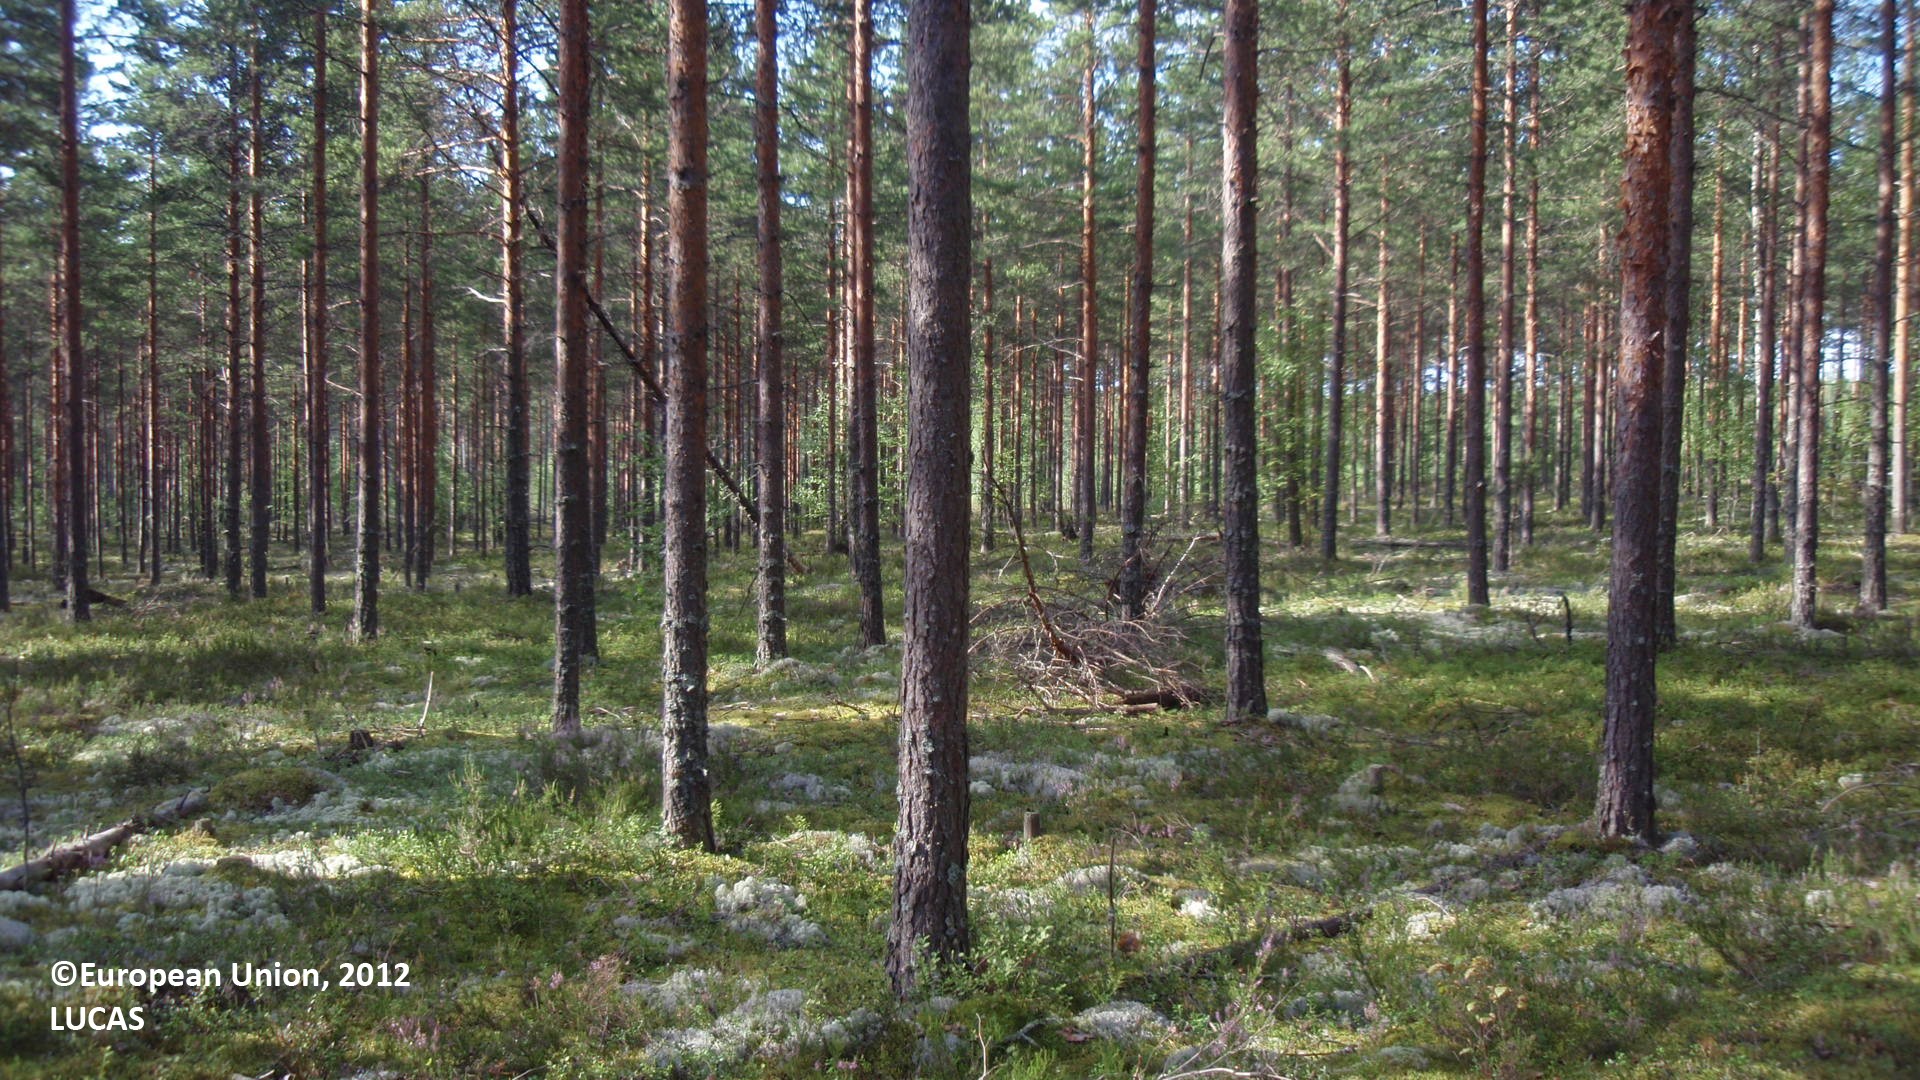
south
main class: Woodland
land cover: Pine dominated coniferous woodland
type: boreal forest
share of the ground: 50 - 75 %
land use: Forestry
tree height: > 5 m
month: August
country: FI
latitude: 61.2654
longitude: 28.0427
